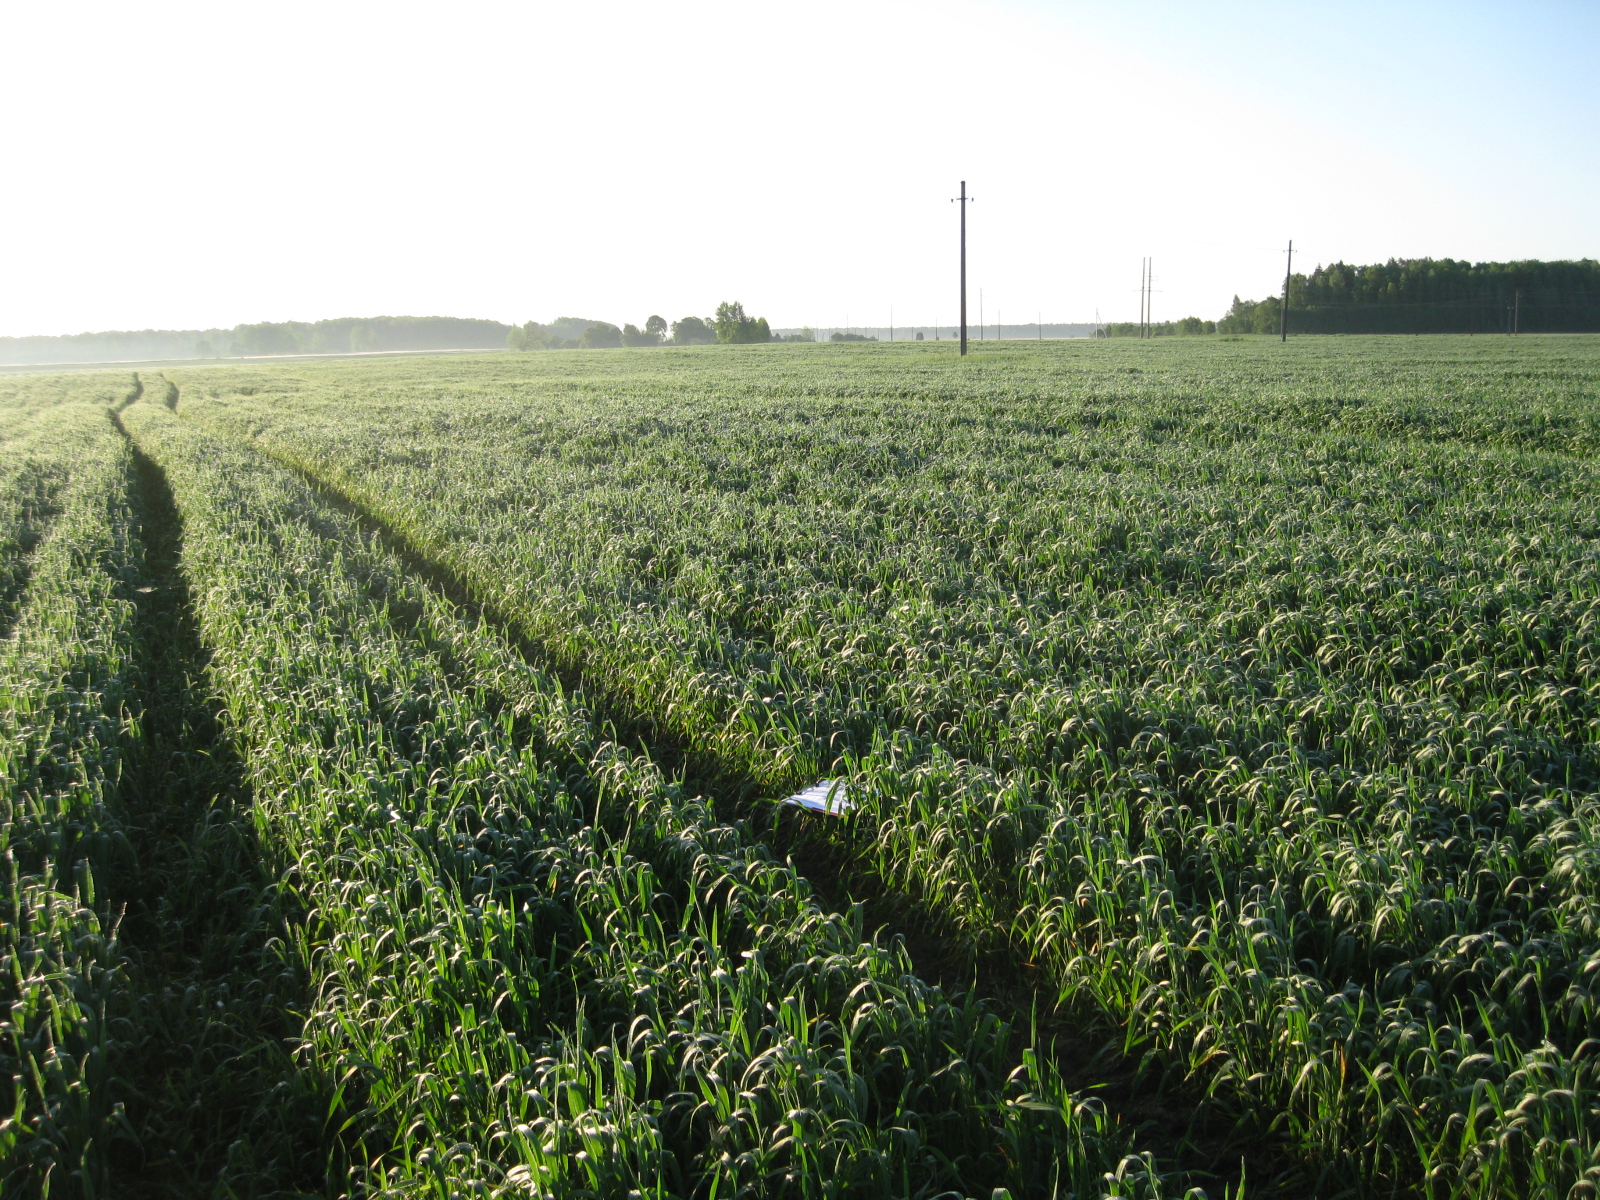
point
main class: Cropland
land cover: Common wheat
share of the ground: > 75 %
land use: Agriculture (excluding fallow land and kitchen gardens)
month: May
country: LT
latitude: 55.6589
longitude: 24.7443
